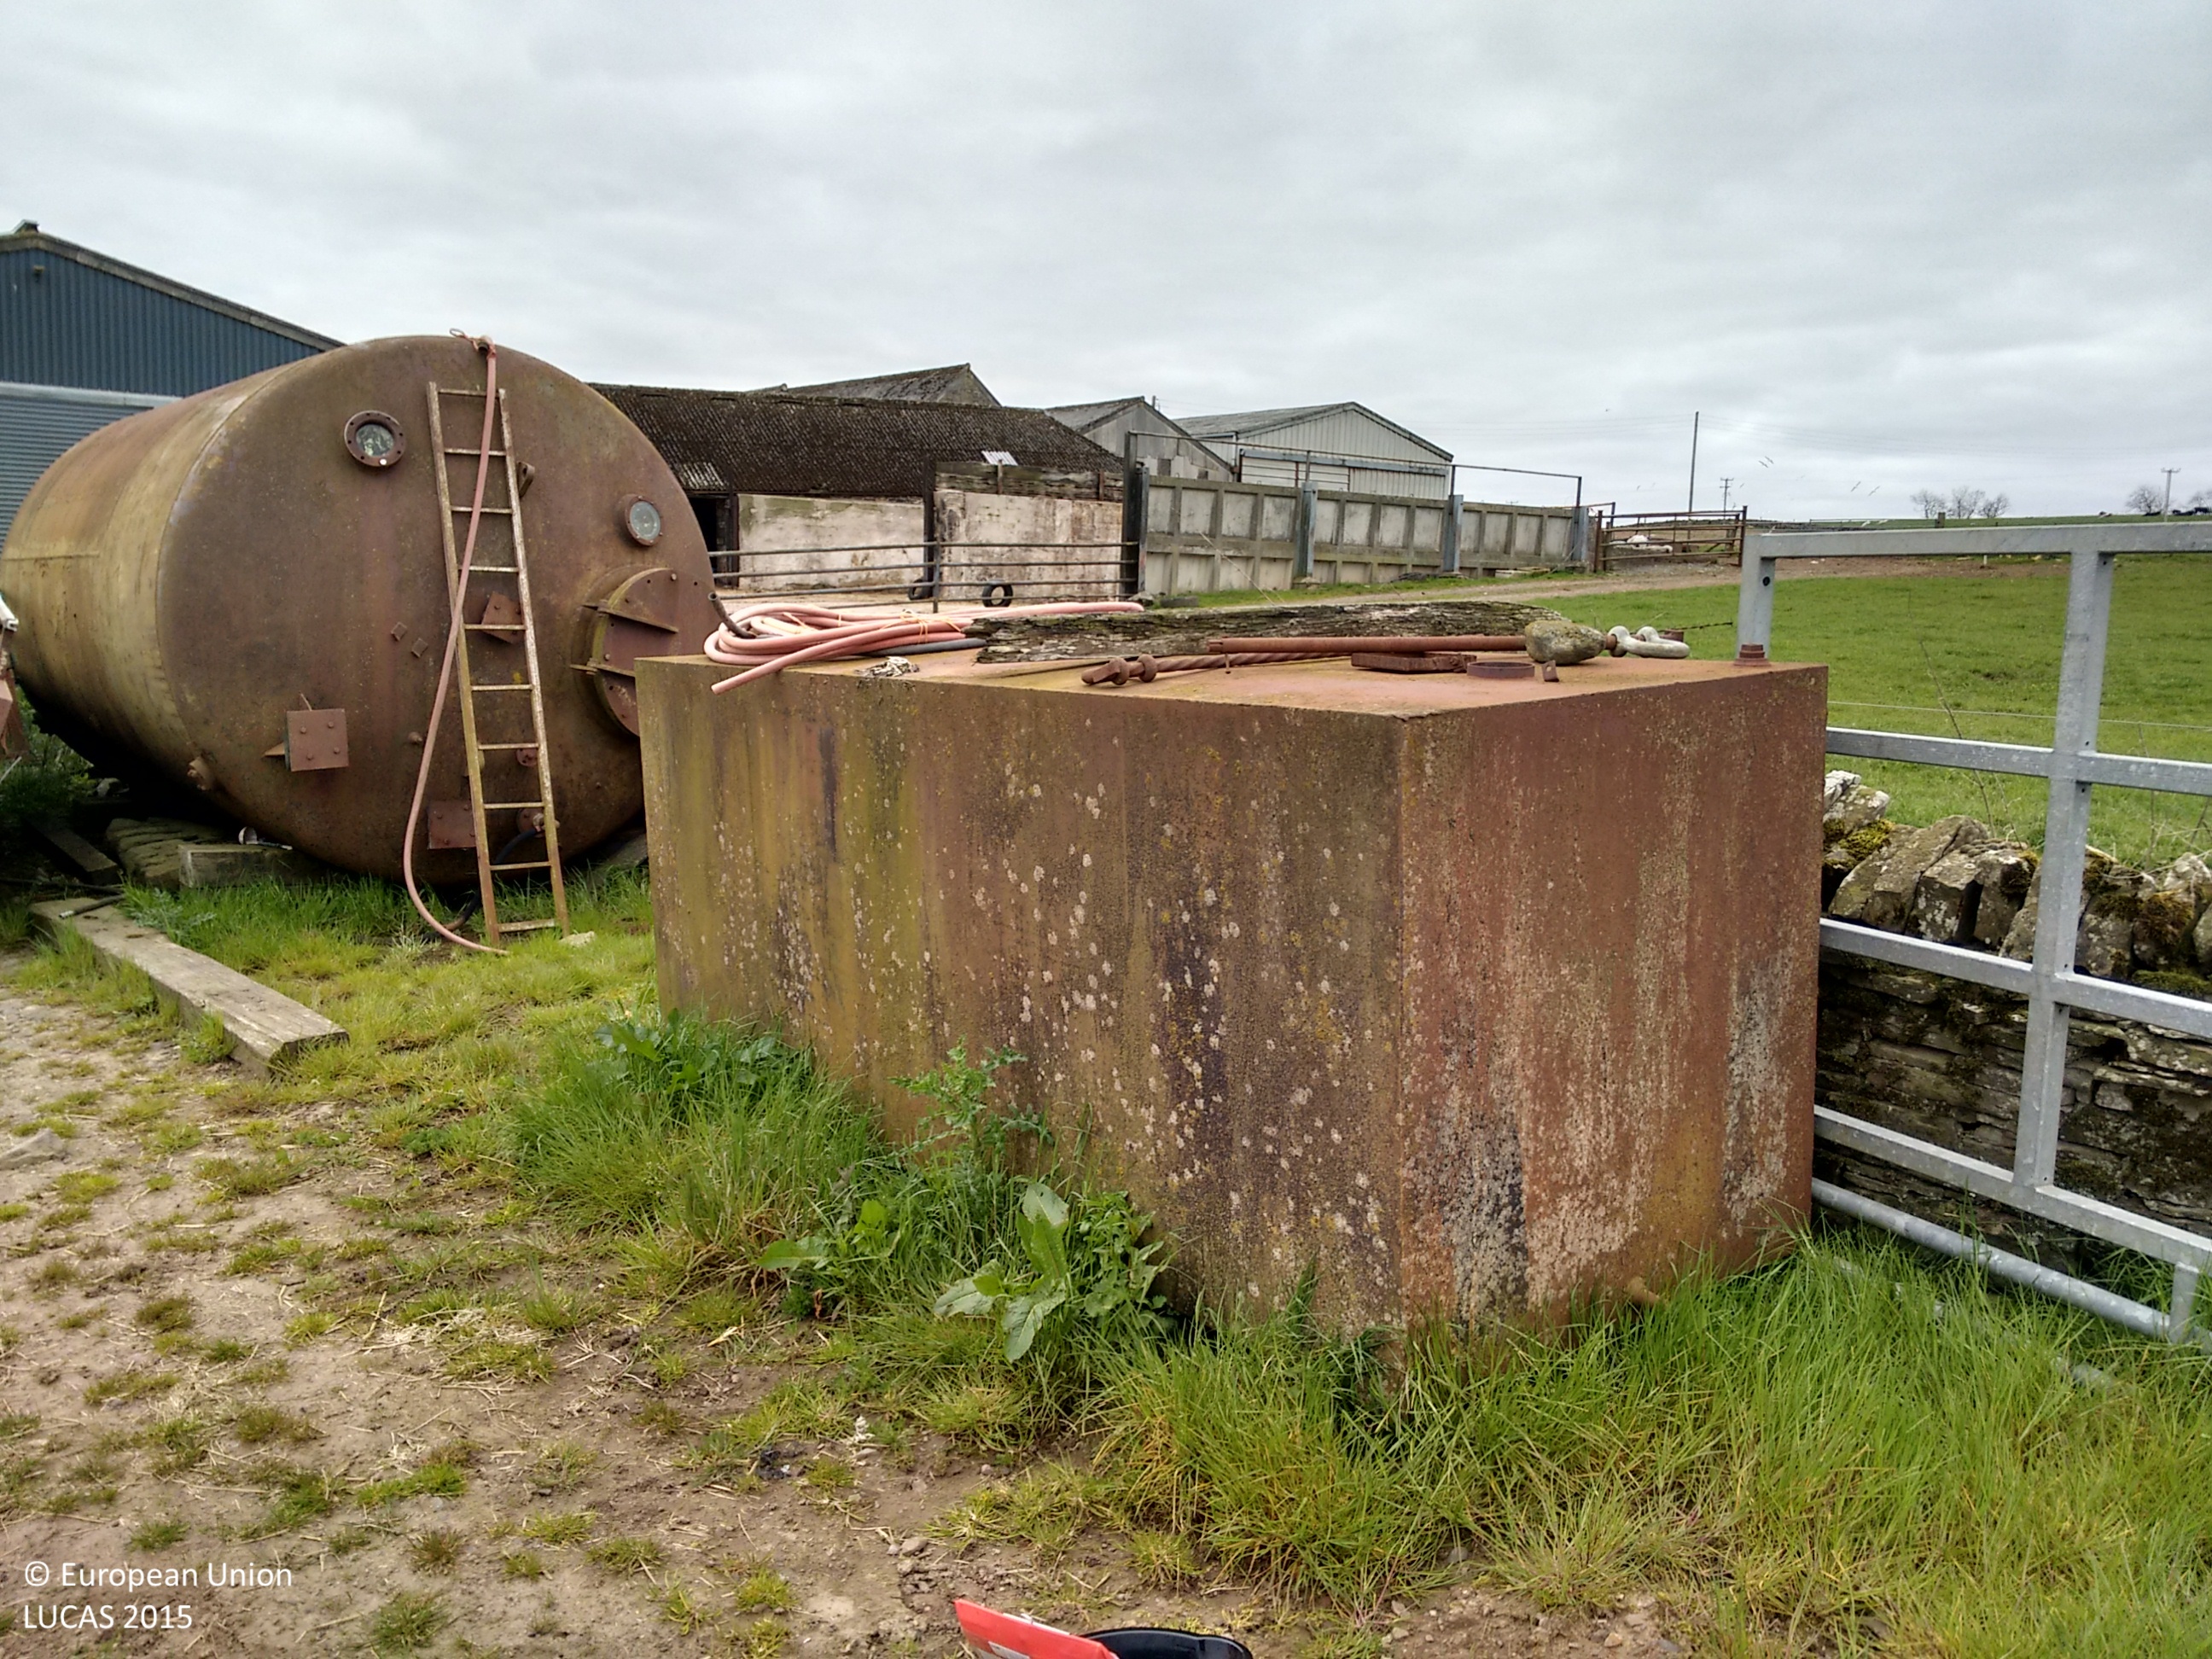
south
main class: Grassland
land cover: Grassland without tree/shrub cover
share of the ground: 50 - 75 %
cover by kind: herbaceous plants 75 %, unconsolidated bare surface 25 %
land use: Agriculture (excluding fallow land and kitchen gardens)
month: May
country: GB
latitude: 56.6763
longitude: -2.7753
